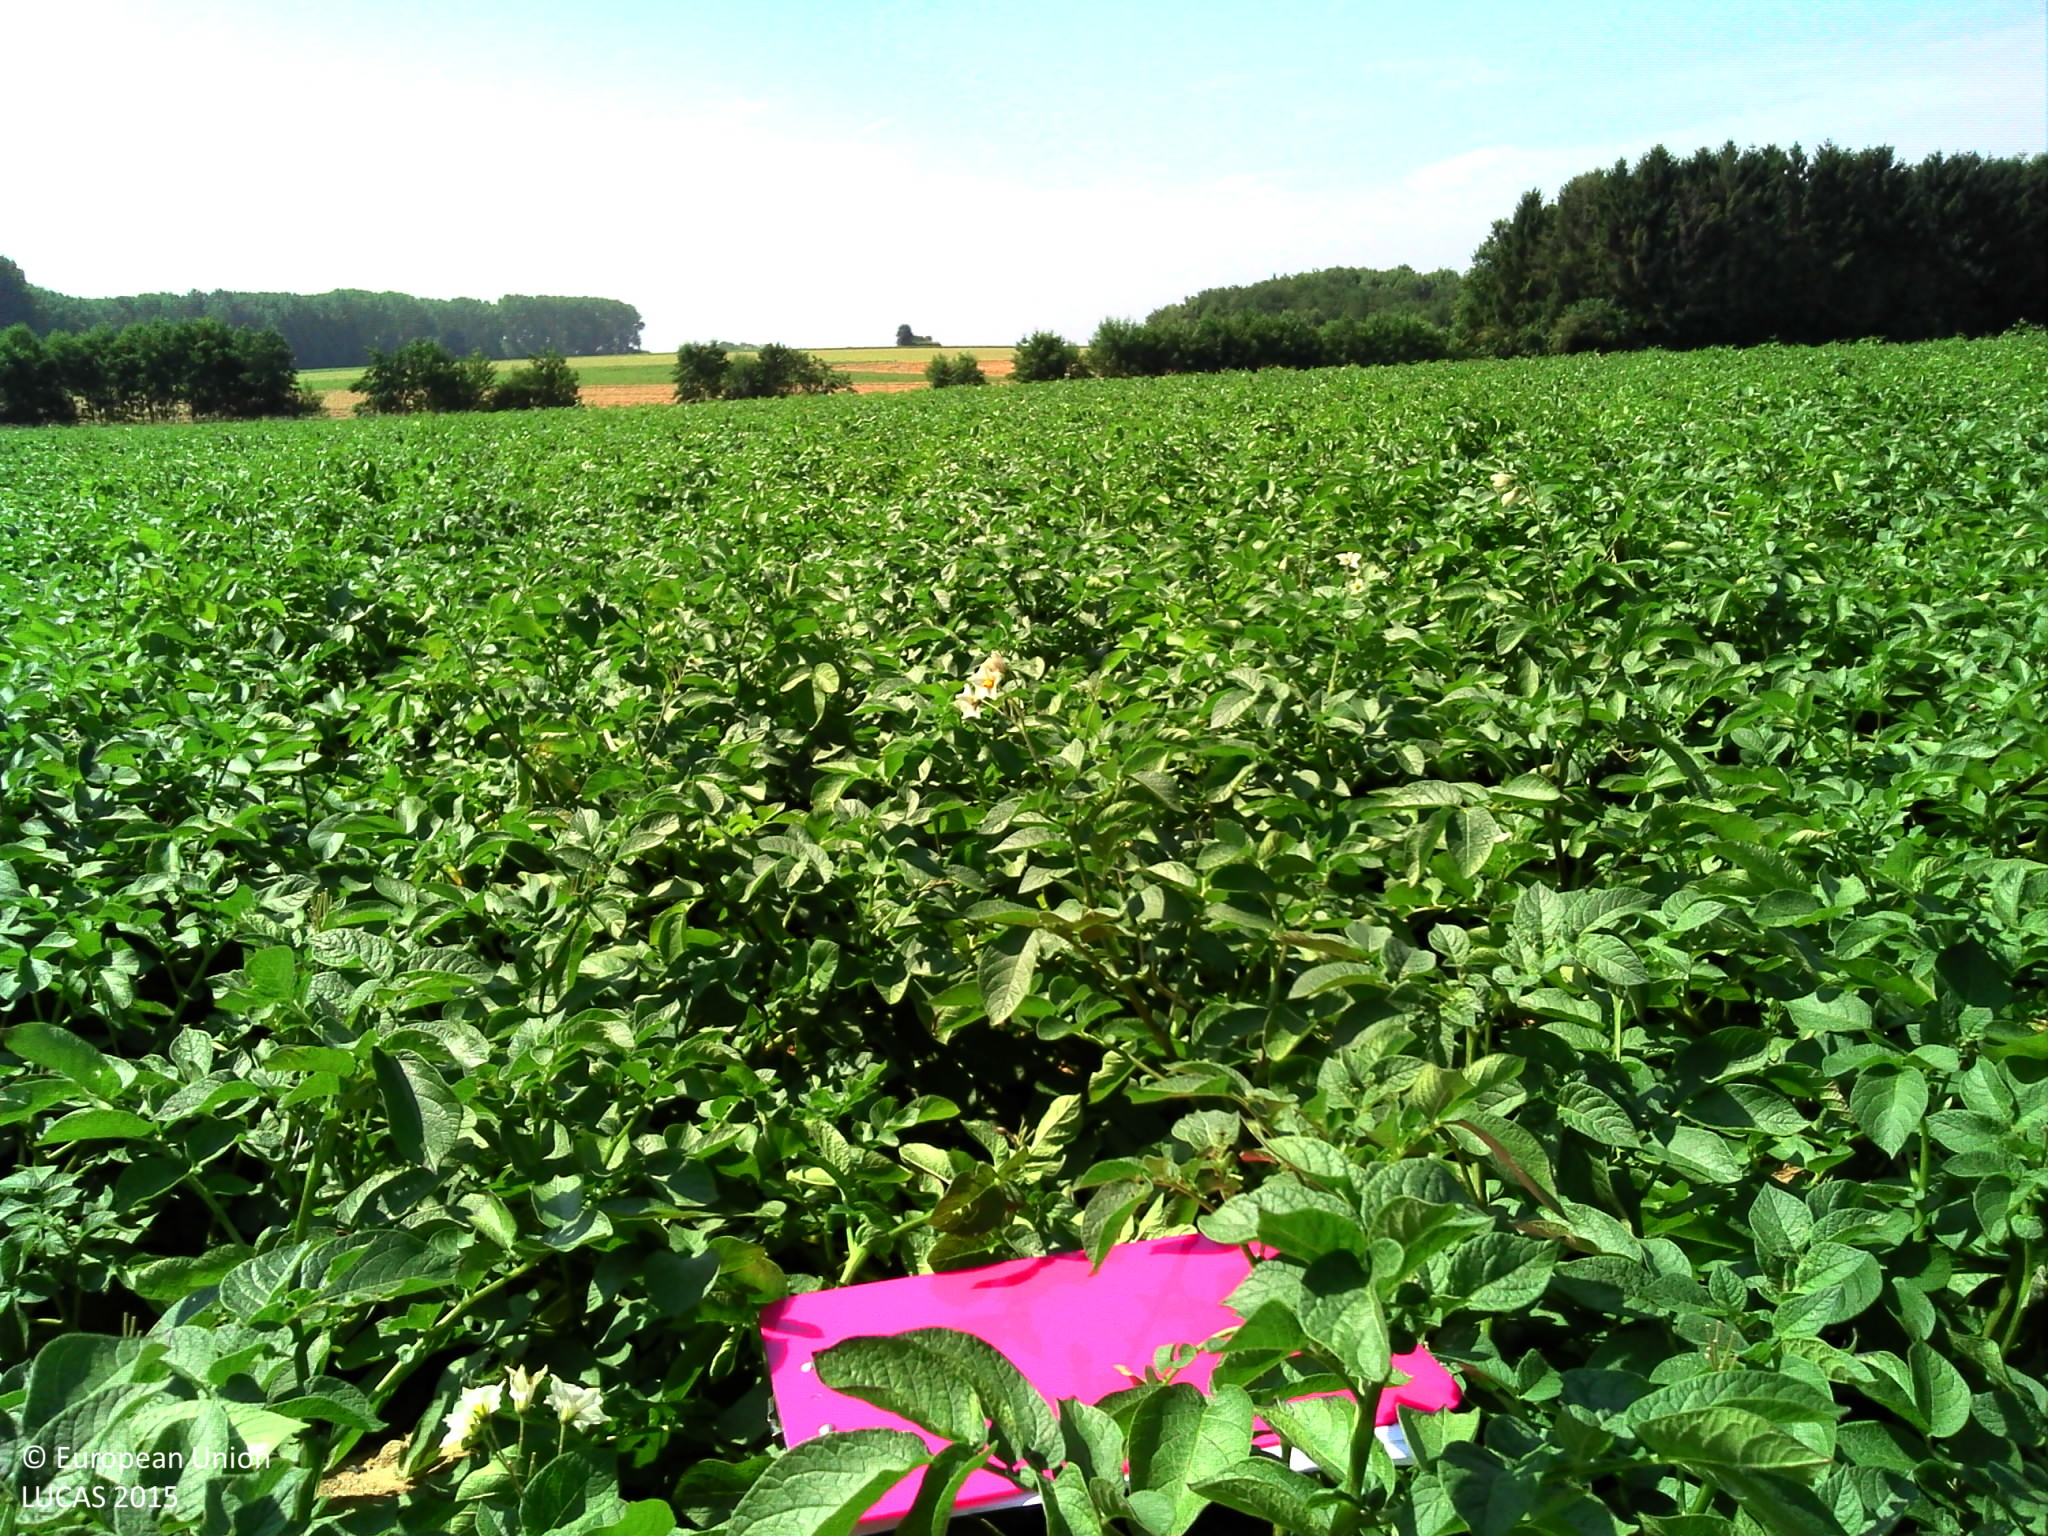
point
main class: Cropland
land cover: Potatoes
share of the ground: > 75 %
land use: Agriculture (excluding fallow land and kitchen gardens)
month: August
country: FR
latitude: 50.3296
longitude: 3.9395
